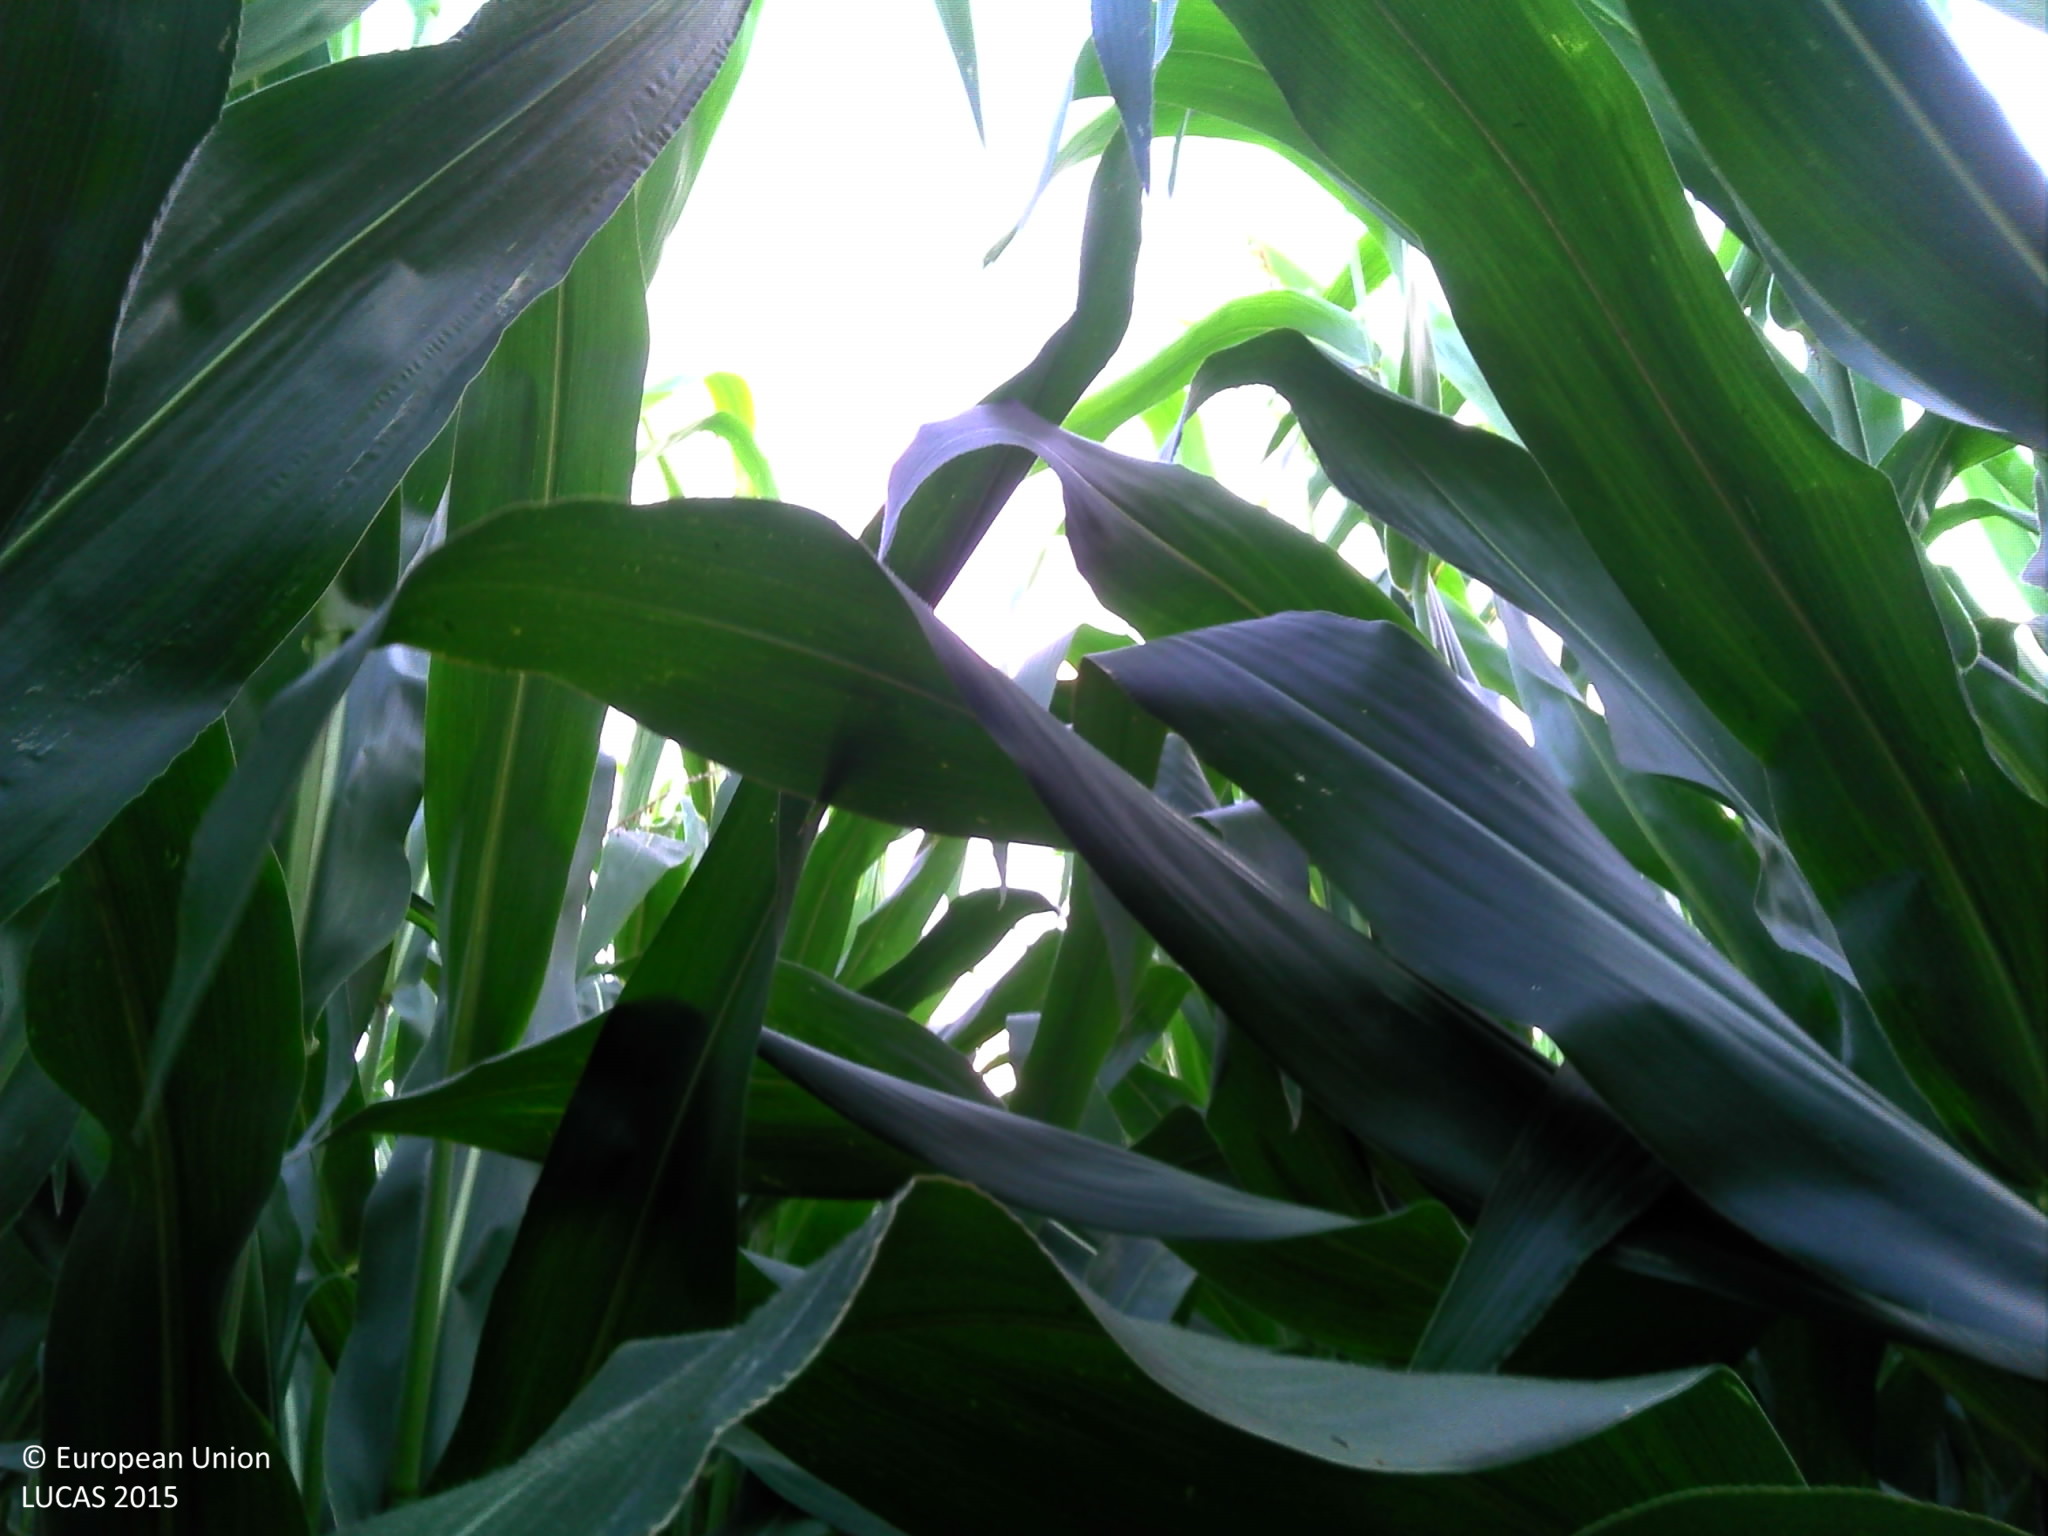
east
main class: Cropland
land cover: Maize
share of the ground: > 75 %
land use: Agriculture (excluding fallow land and kitchen gardens)
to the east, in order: Maize; Fences; Temporary grasslands; Common wheat
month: August
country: FR
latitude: 48.6759
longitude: -3.2622
